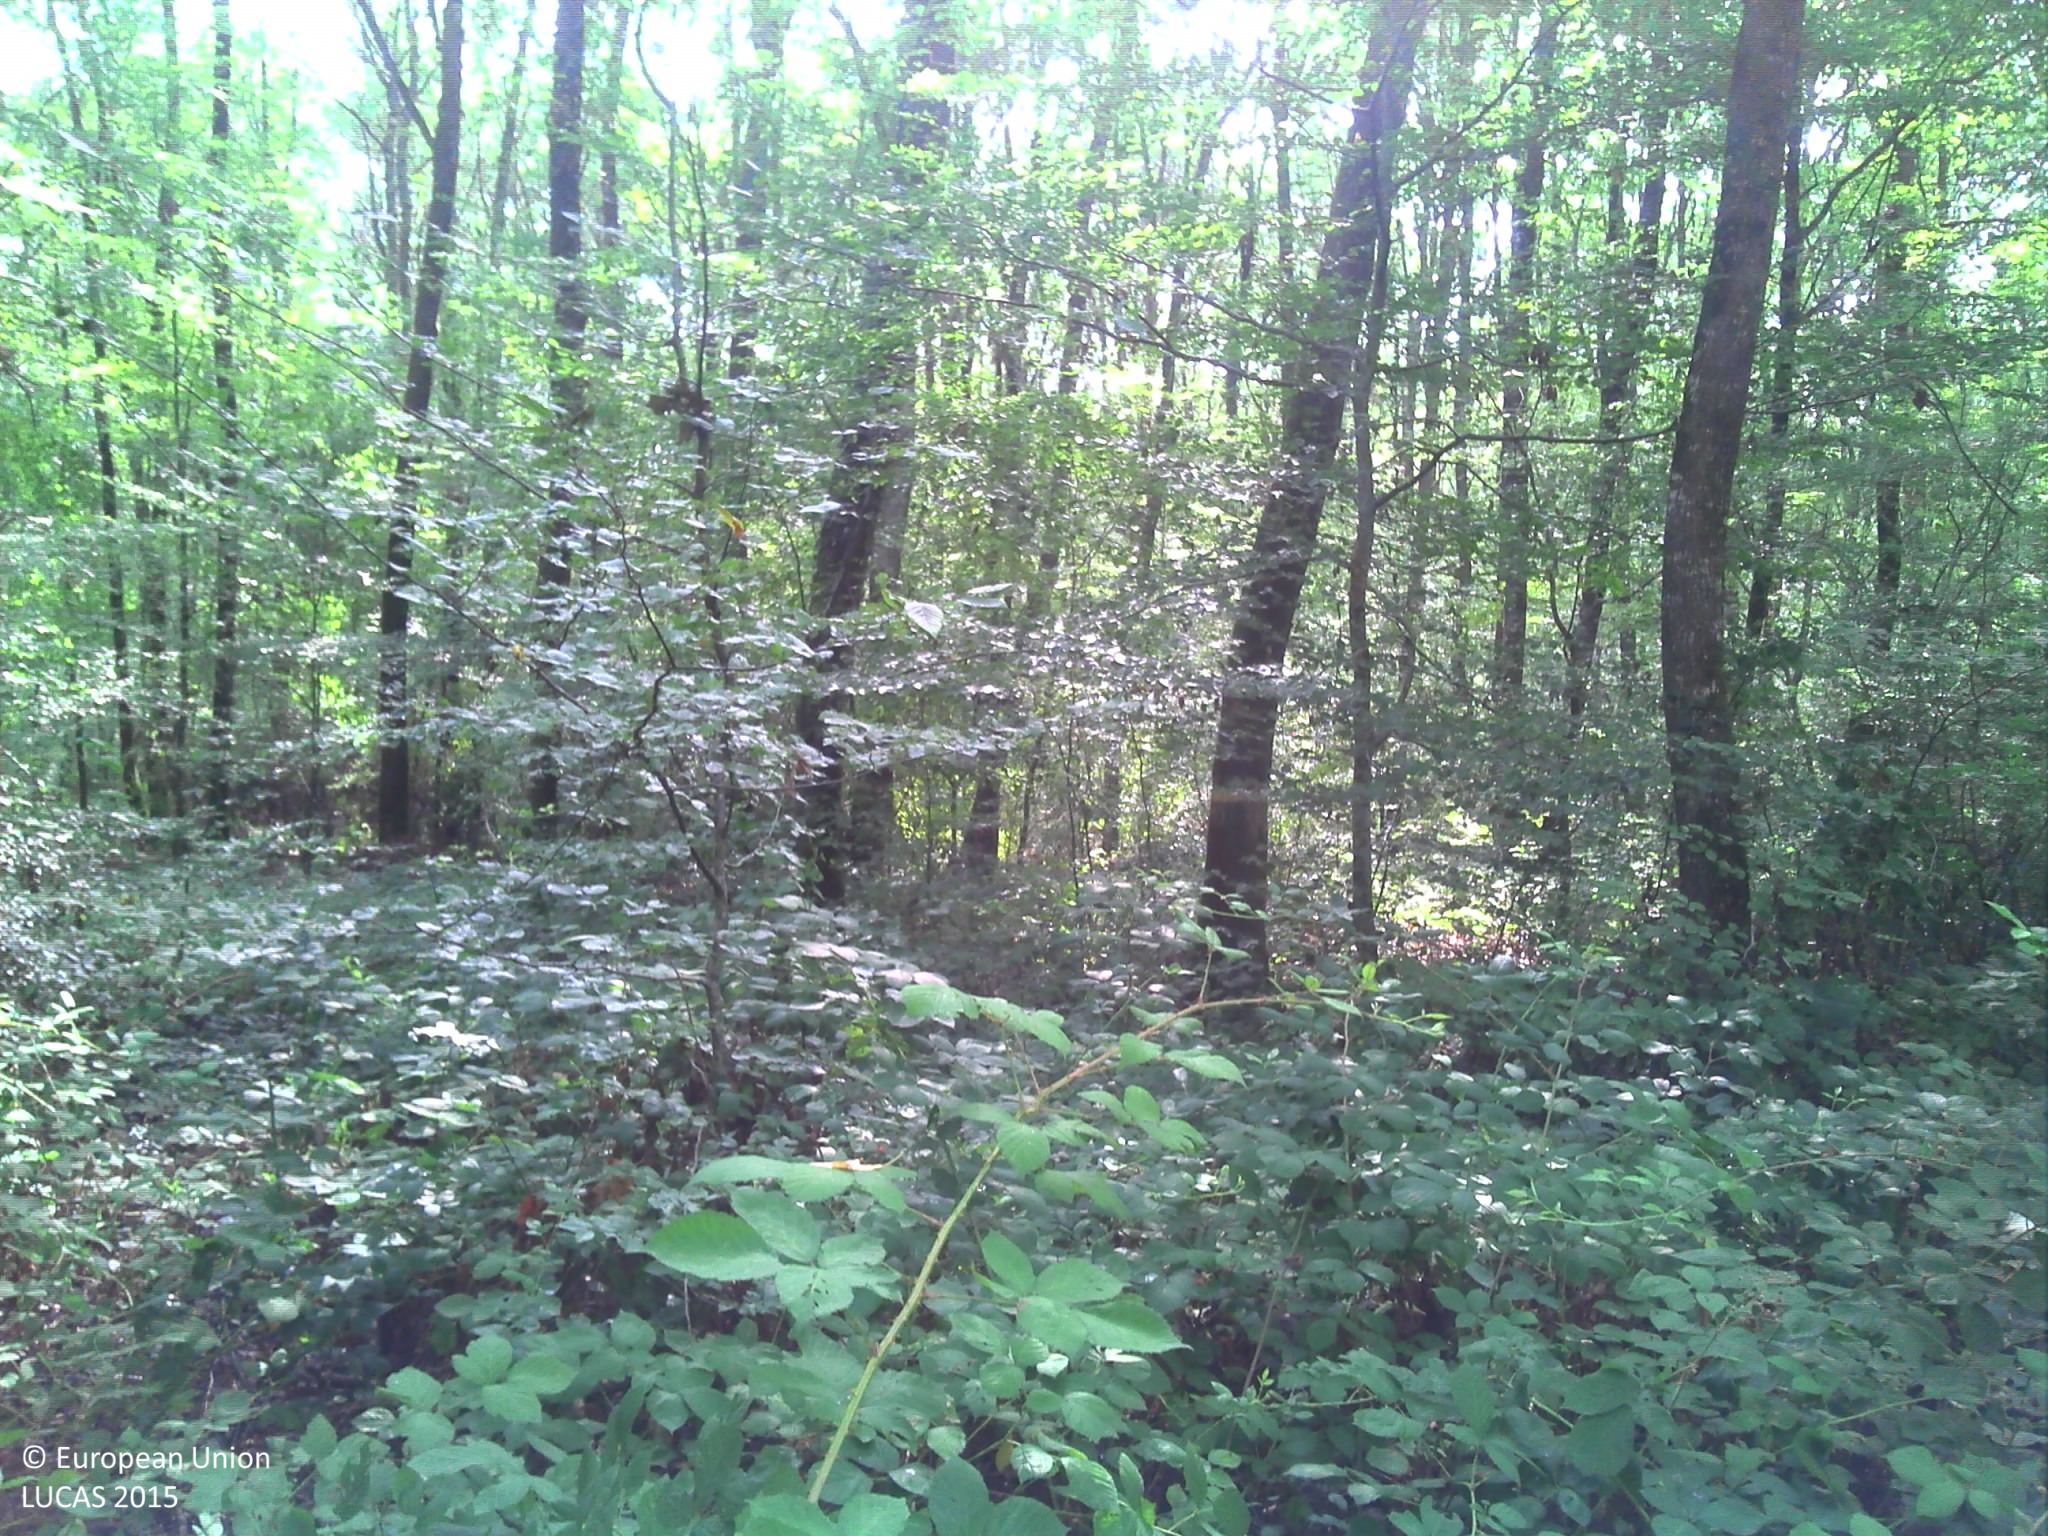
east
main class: Woodland
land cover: Broadleaved woodland
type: mesophytic deciduous forest
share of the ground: > 75 %
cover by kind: broadleaved forest trees 90 %, shrubs 10 %
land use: Forestry
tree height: > 5 m
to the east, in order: Broadleaved woodland
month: August
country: FR
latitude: 46.5000
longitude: 3.2614
